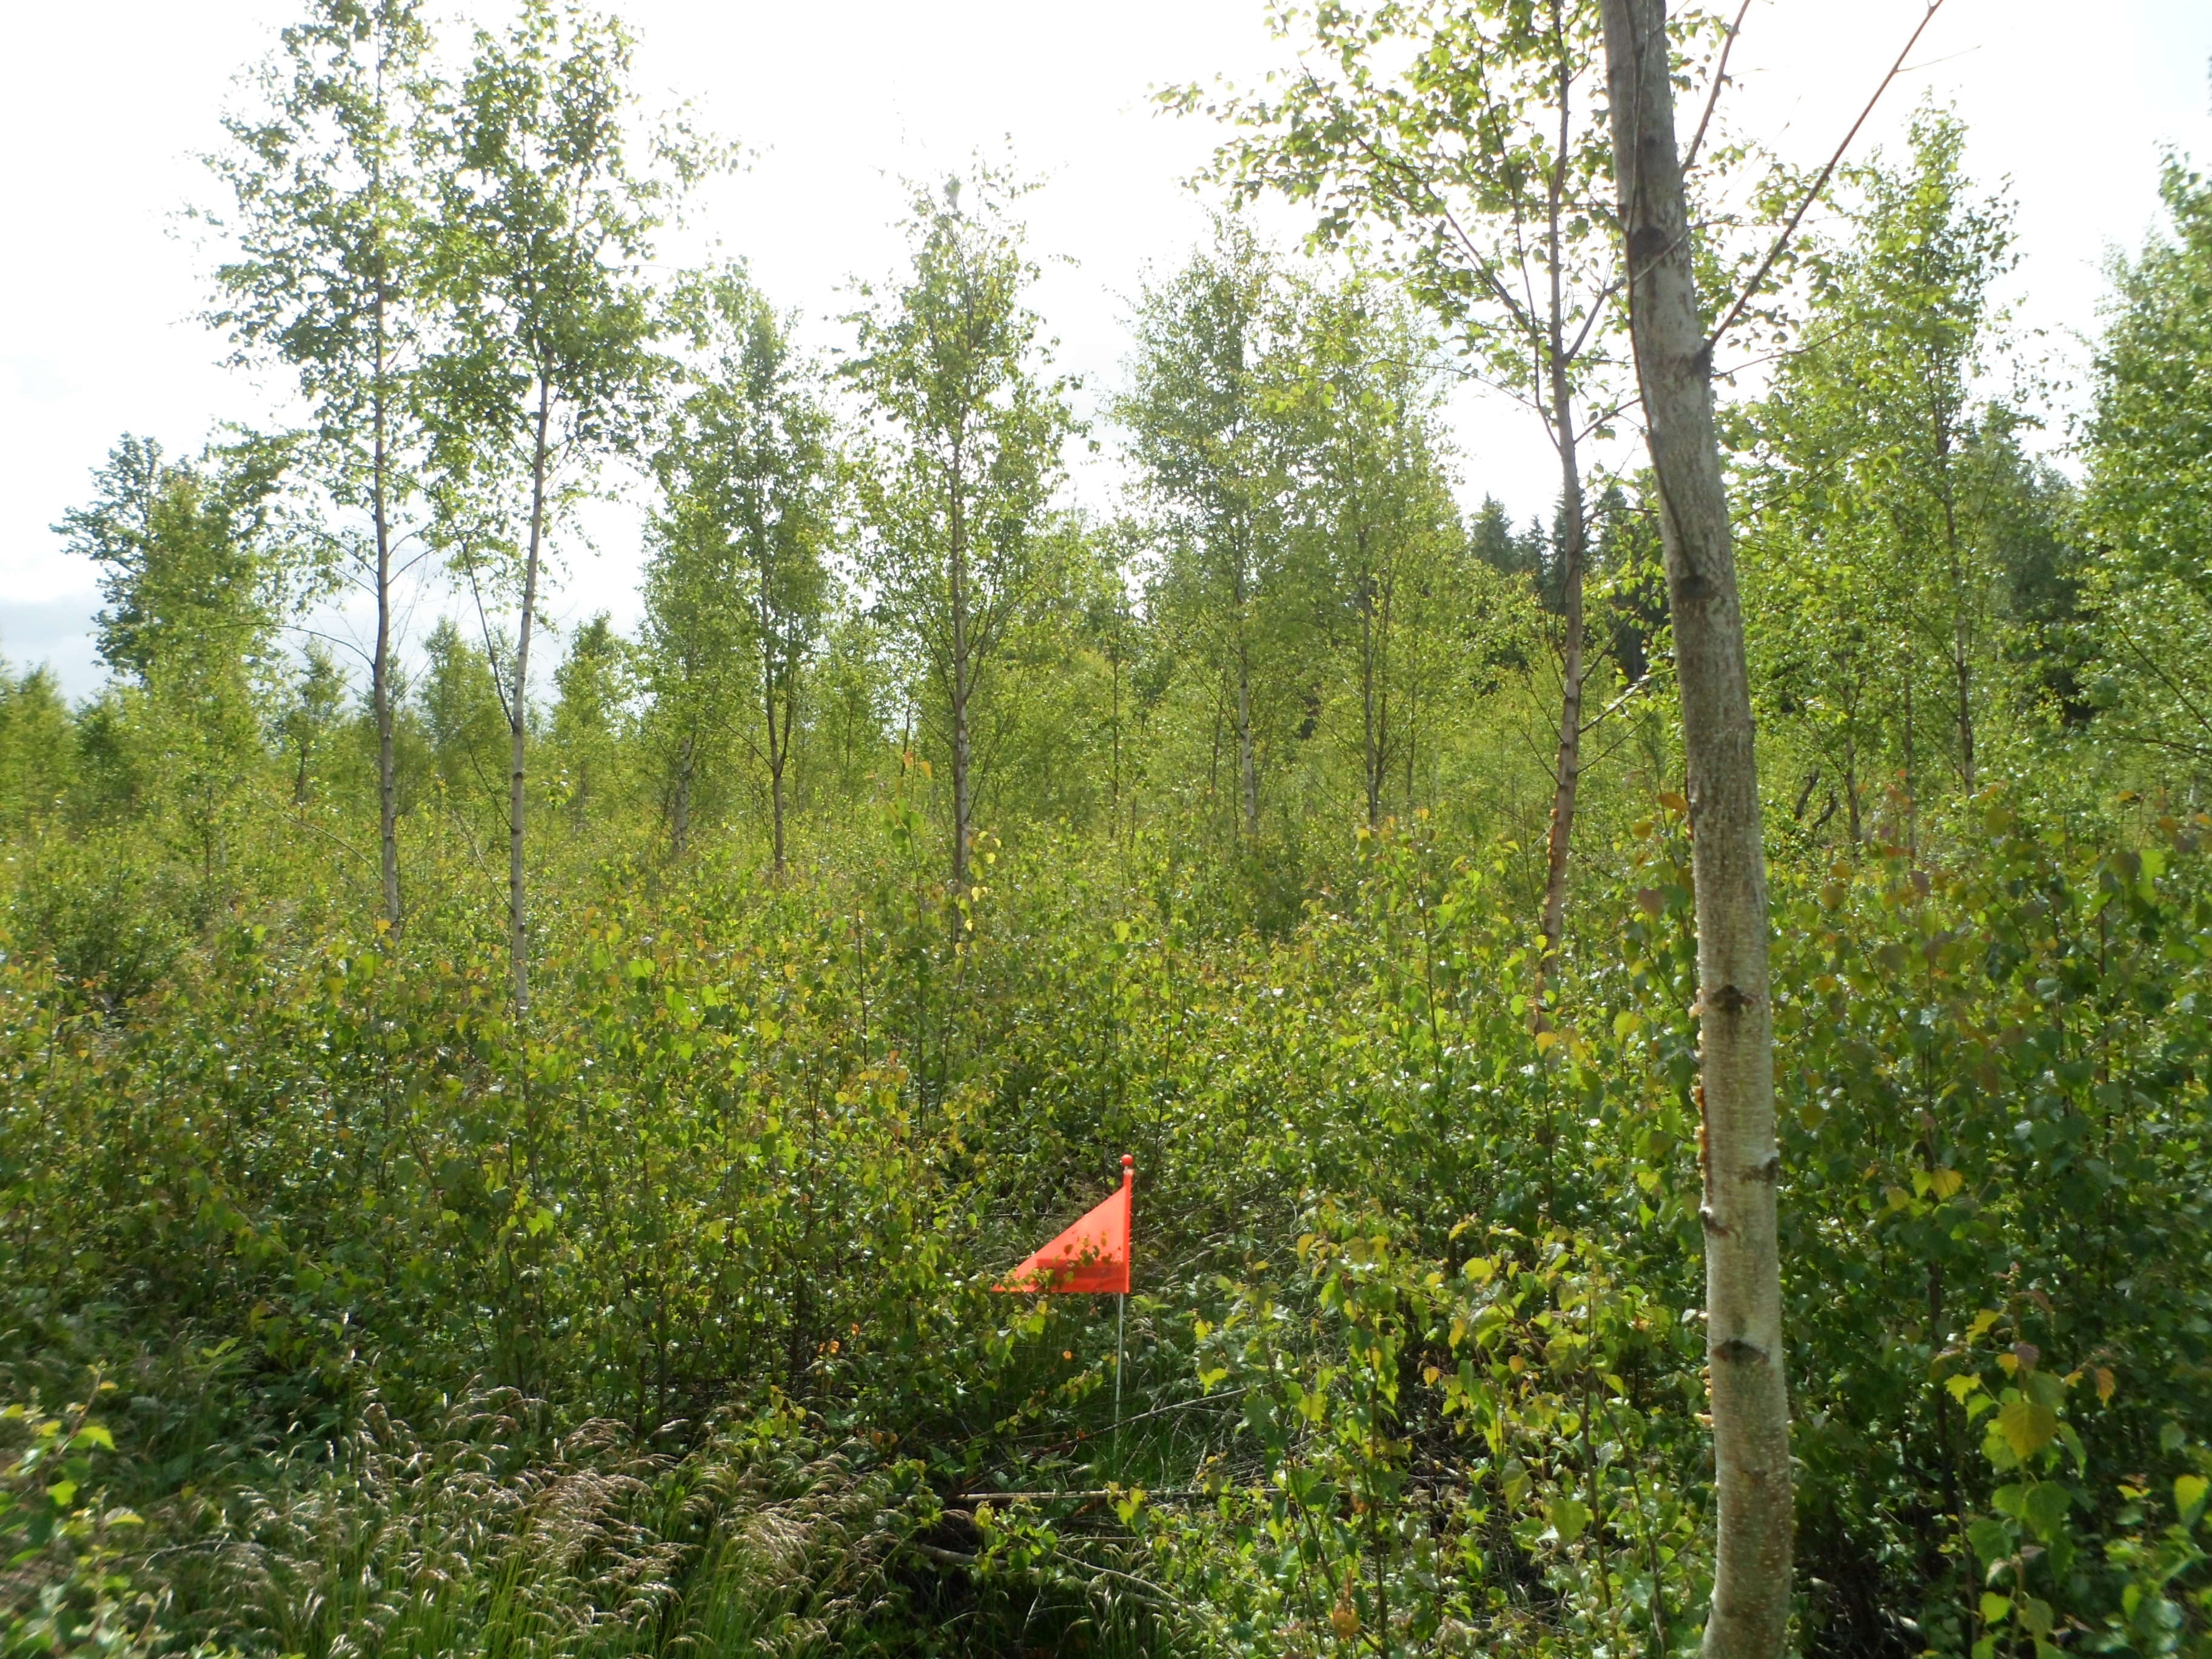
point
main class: Woodland
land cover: Broadleaved woodland
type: boreal forest
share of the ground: > 75 %
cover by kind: broadleaved forest trees 70 %, herbaceous plants 15 %, coniferous forest trees 10 %, shrubs 5 %
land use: Forestry
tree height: < 5 m
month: June
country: SE
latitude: 56.9322
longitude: 14.6473
